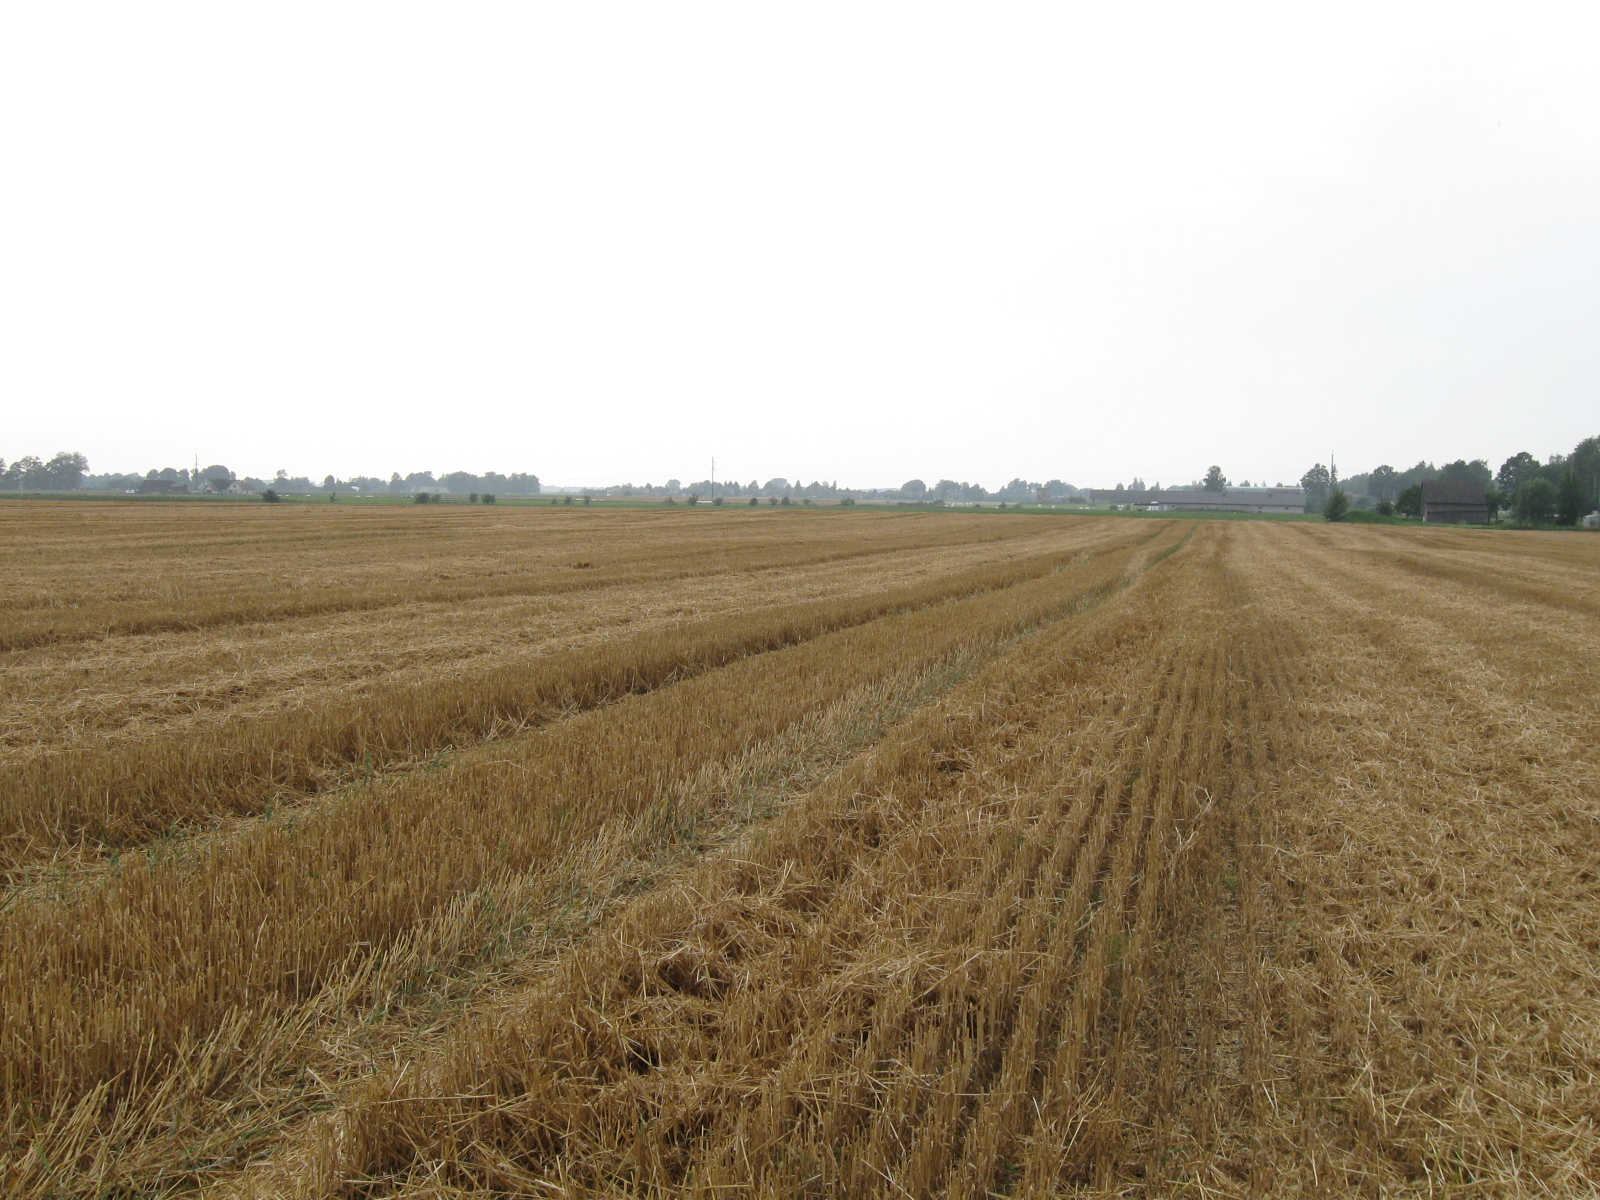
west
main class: Cropland
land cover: Common wheat
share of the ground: > 75 %
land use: Agriculture (excluding fallow land and kitchen gardens)
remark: Harvested field
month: August
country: LT
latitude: 54.6741
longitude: 23.4321
